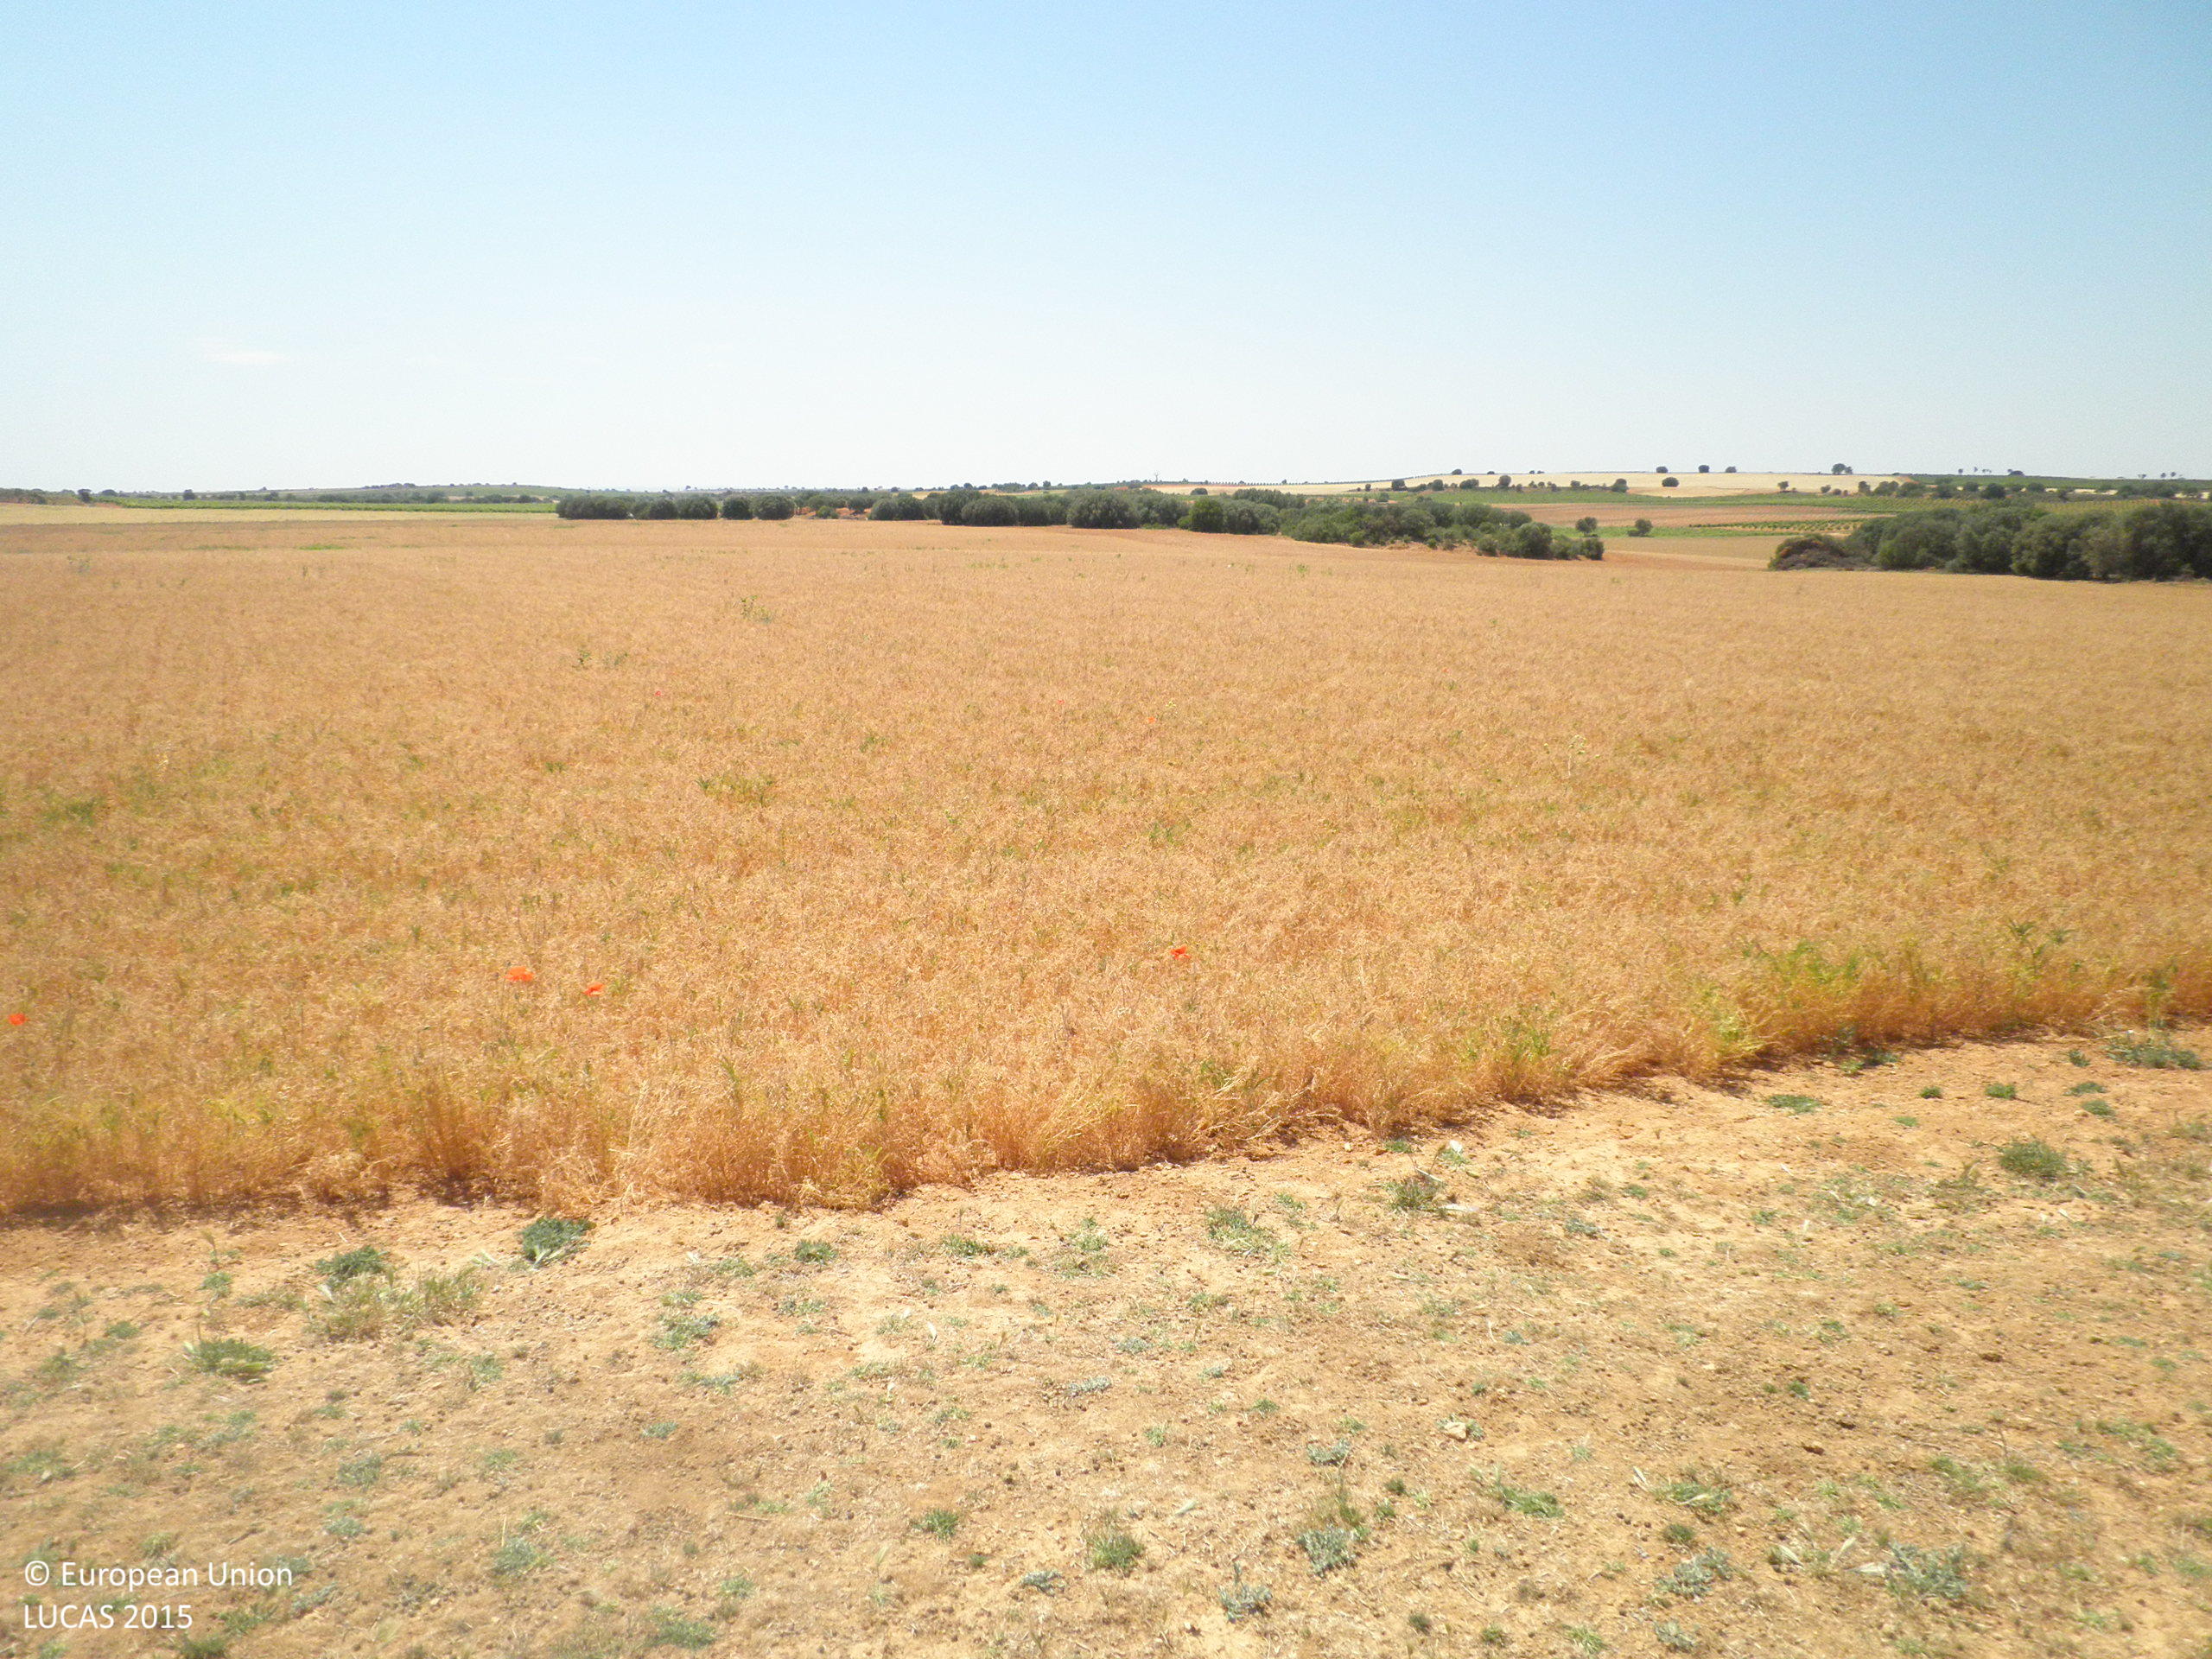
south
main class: Cropland
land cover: Dry pulses
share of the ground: > 75 %
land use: Agriculture (excluding fallow land and kitchen gardens)
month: June
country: ES
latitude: 39.4224
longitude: -1.8189
